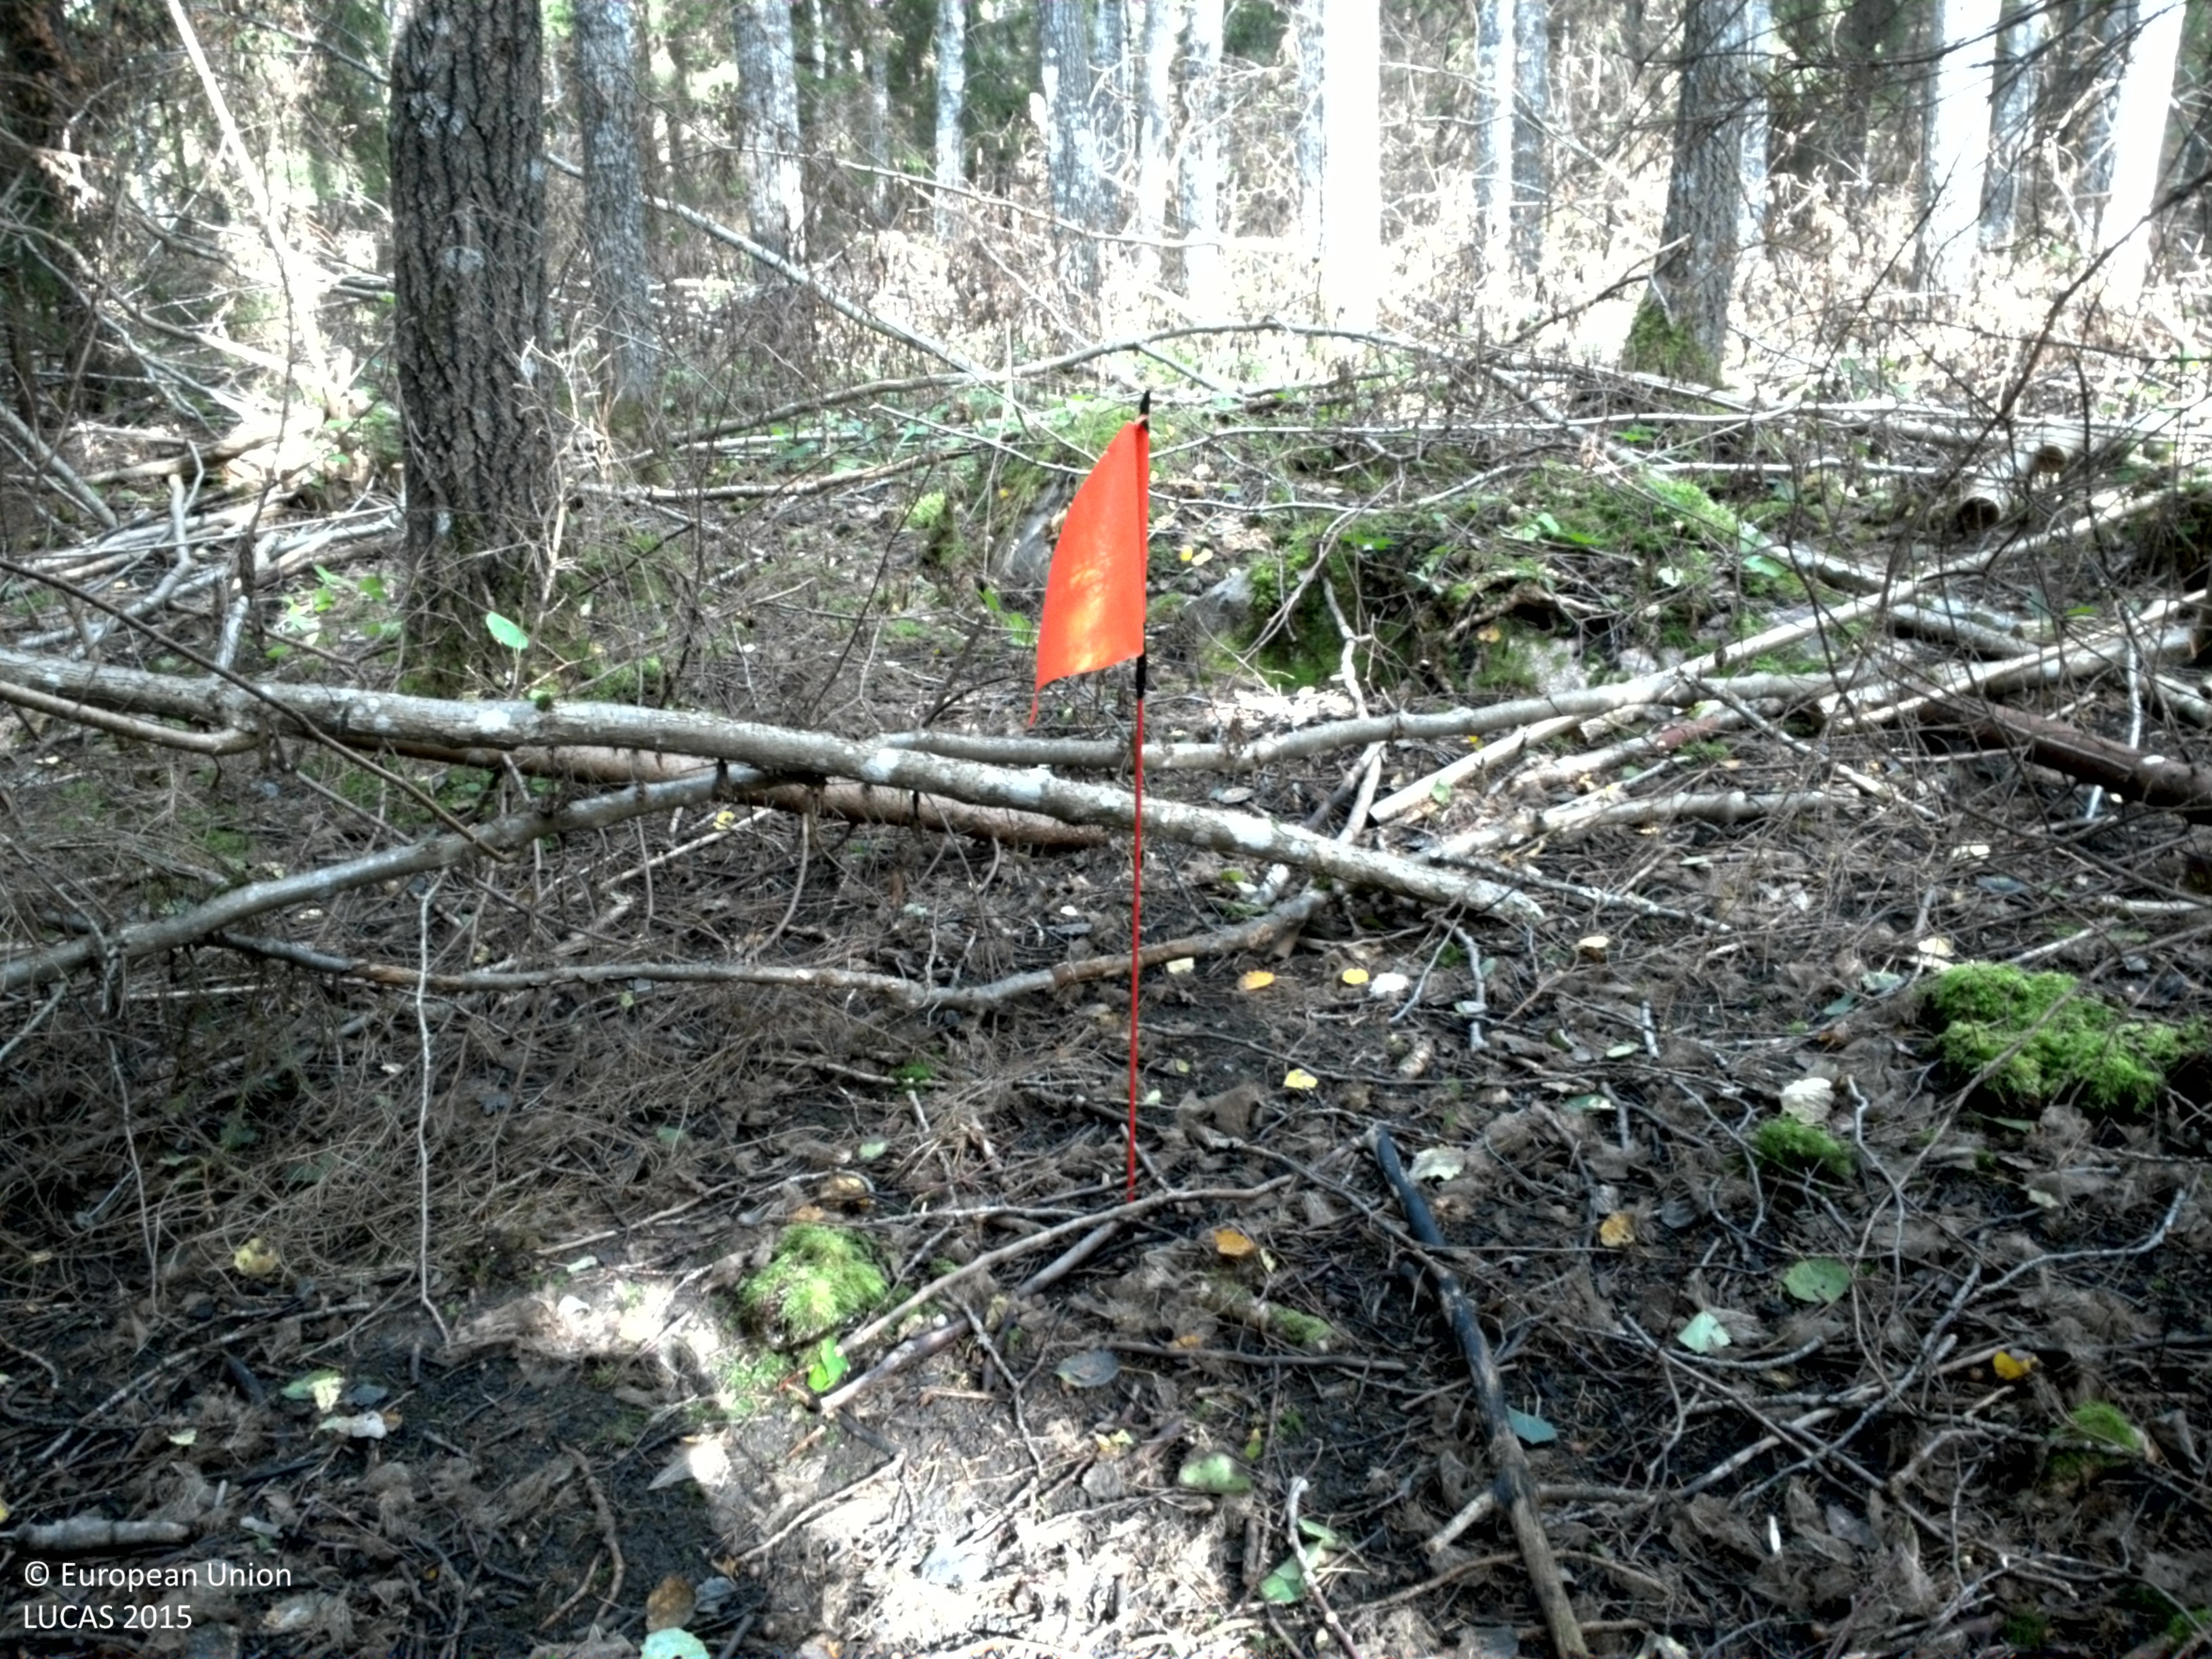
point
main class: Woodland
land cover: Broadleaved woodland
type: hemiboreal forest and nemoral coniferous forest and mixed broadleaved-coniferous forest
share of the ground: > 75 %
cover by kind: broadleaved forest trees 70 %, coniferous forest trees 10 %, lichens and mosses 10 %, unconsolidated bare surface 10 %
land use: Forestry
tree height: > 5 m
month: September
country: SE
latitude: 59.8844
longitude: 18.8448
